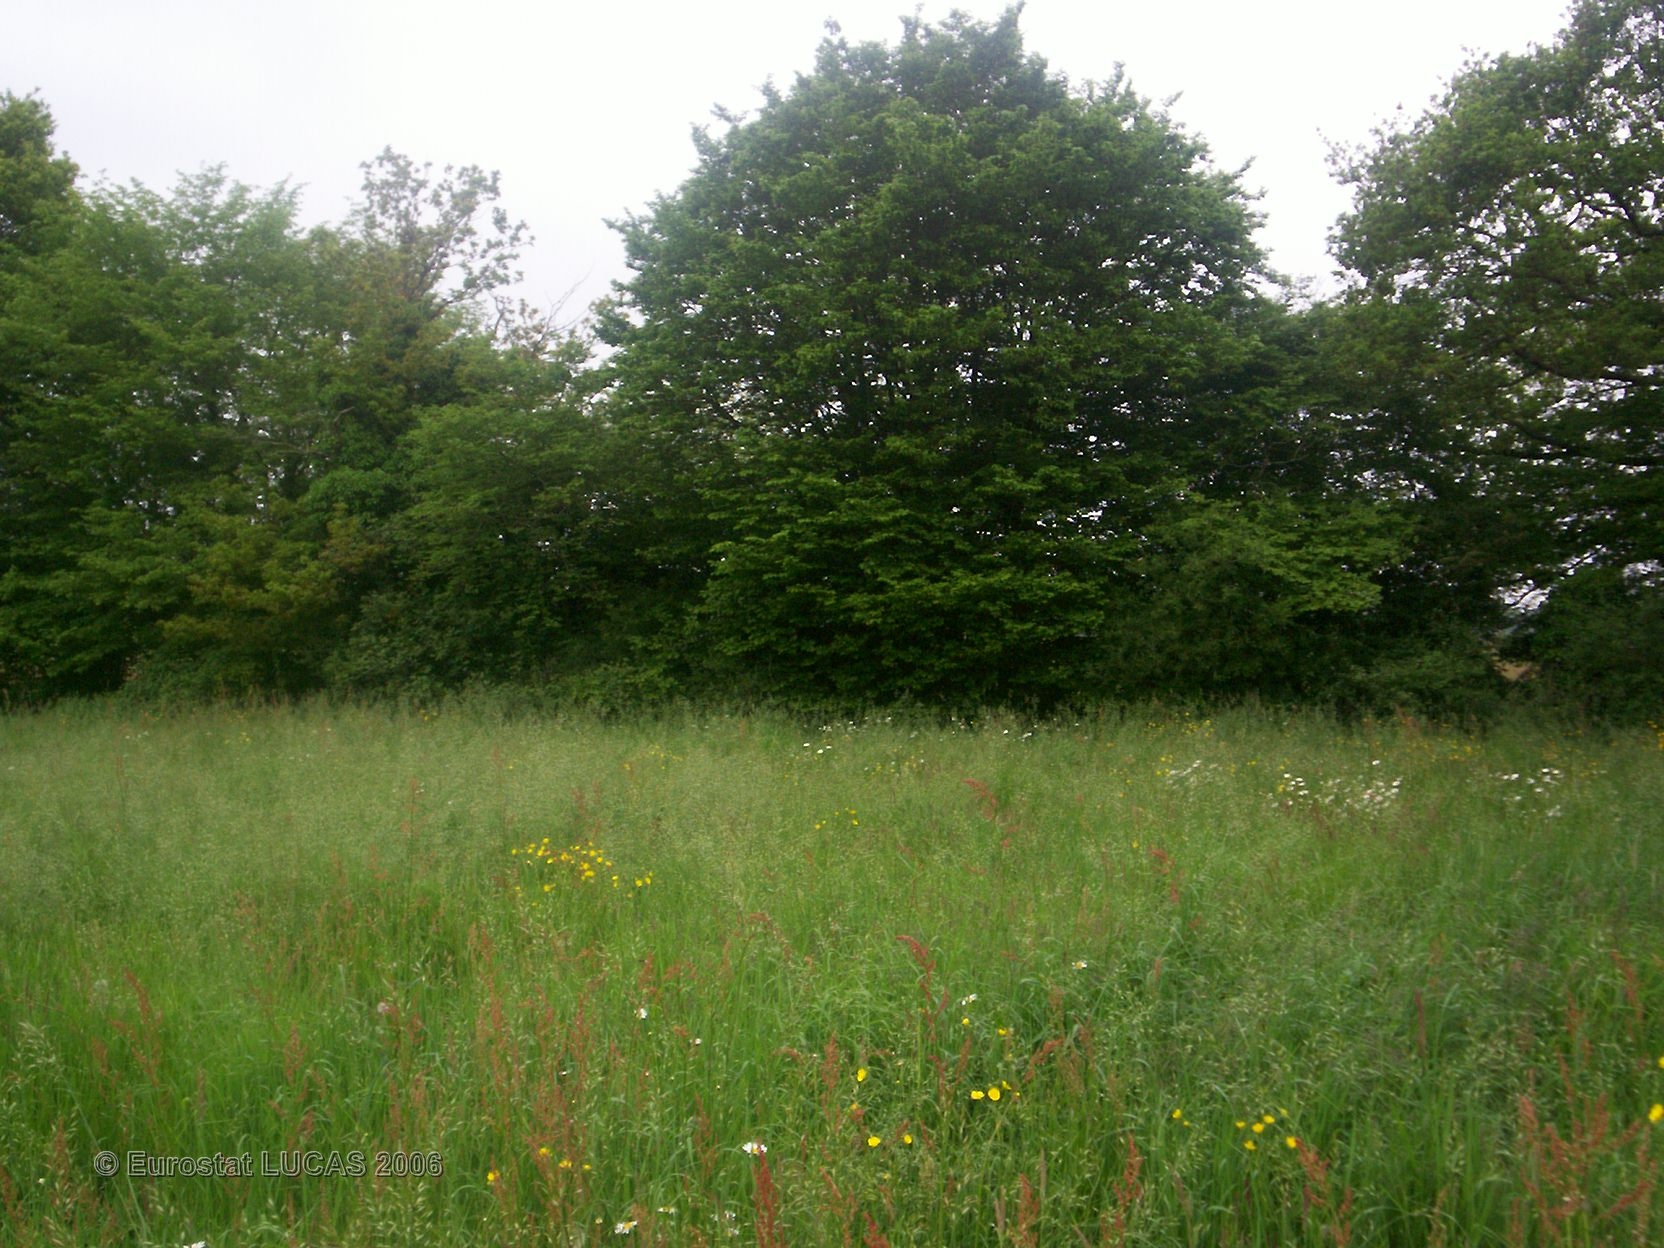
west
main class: Grassland
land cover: Grassland without tree/shrub cover
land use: Agriculture (excluding fallow land and kitchen gardens)
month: May
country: FR
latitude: 47.8264
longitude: 0.4527
